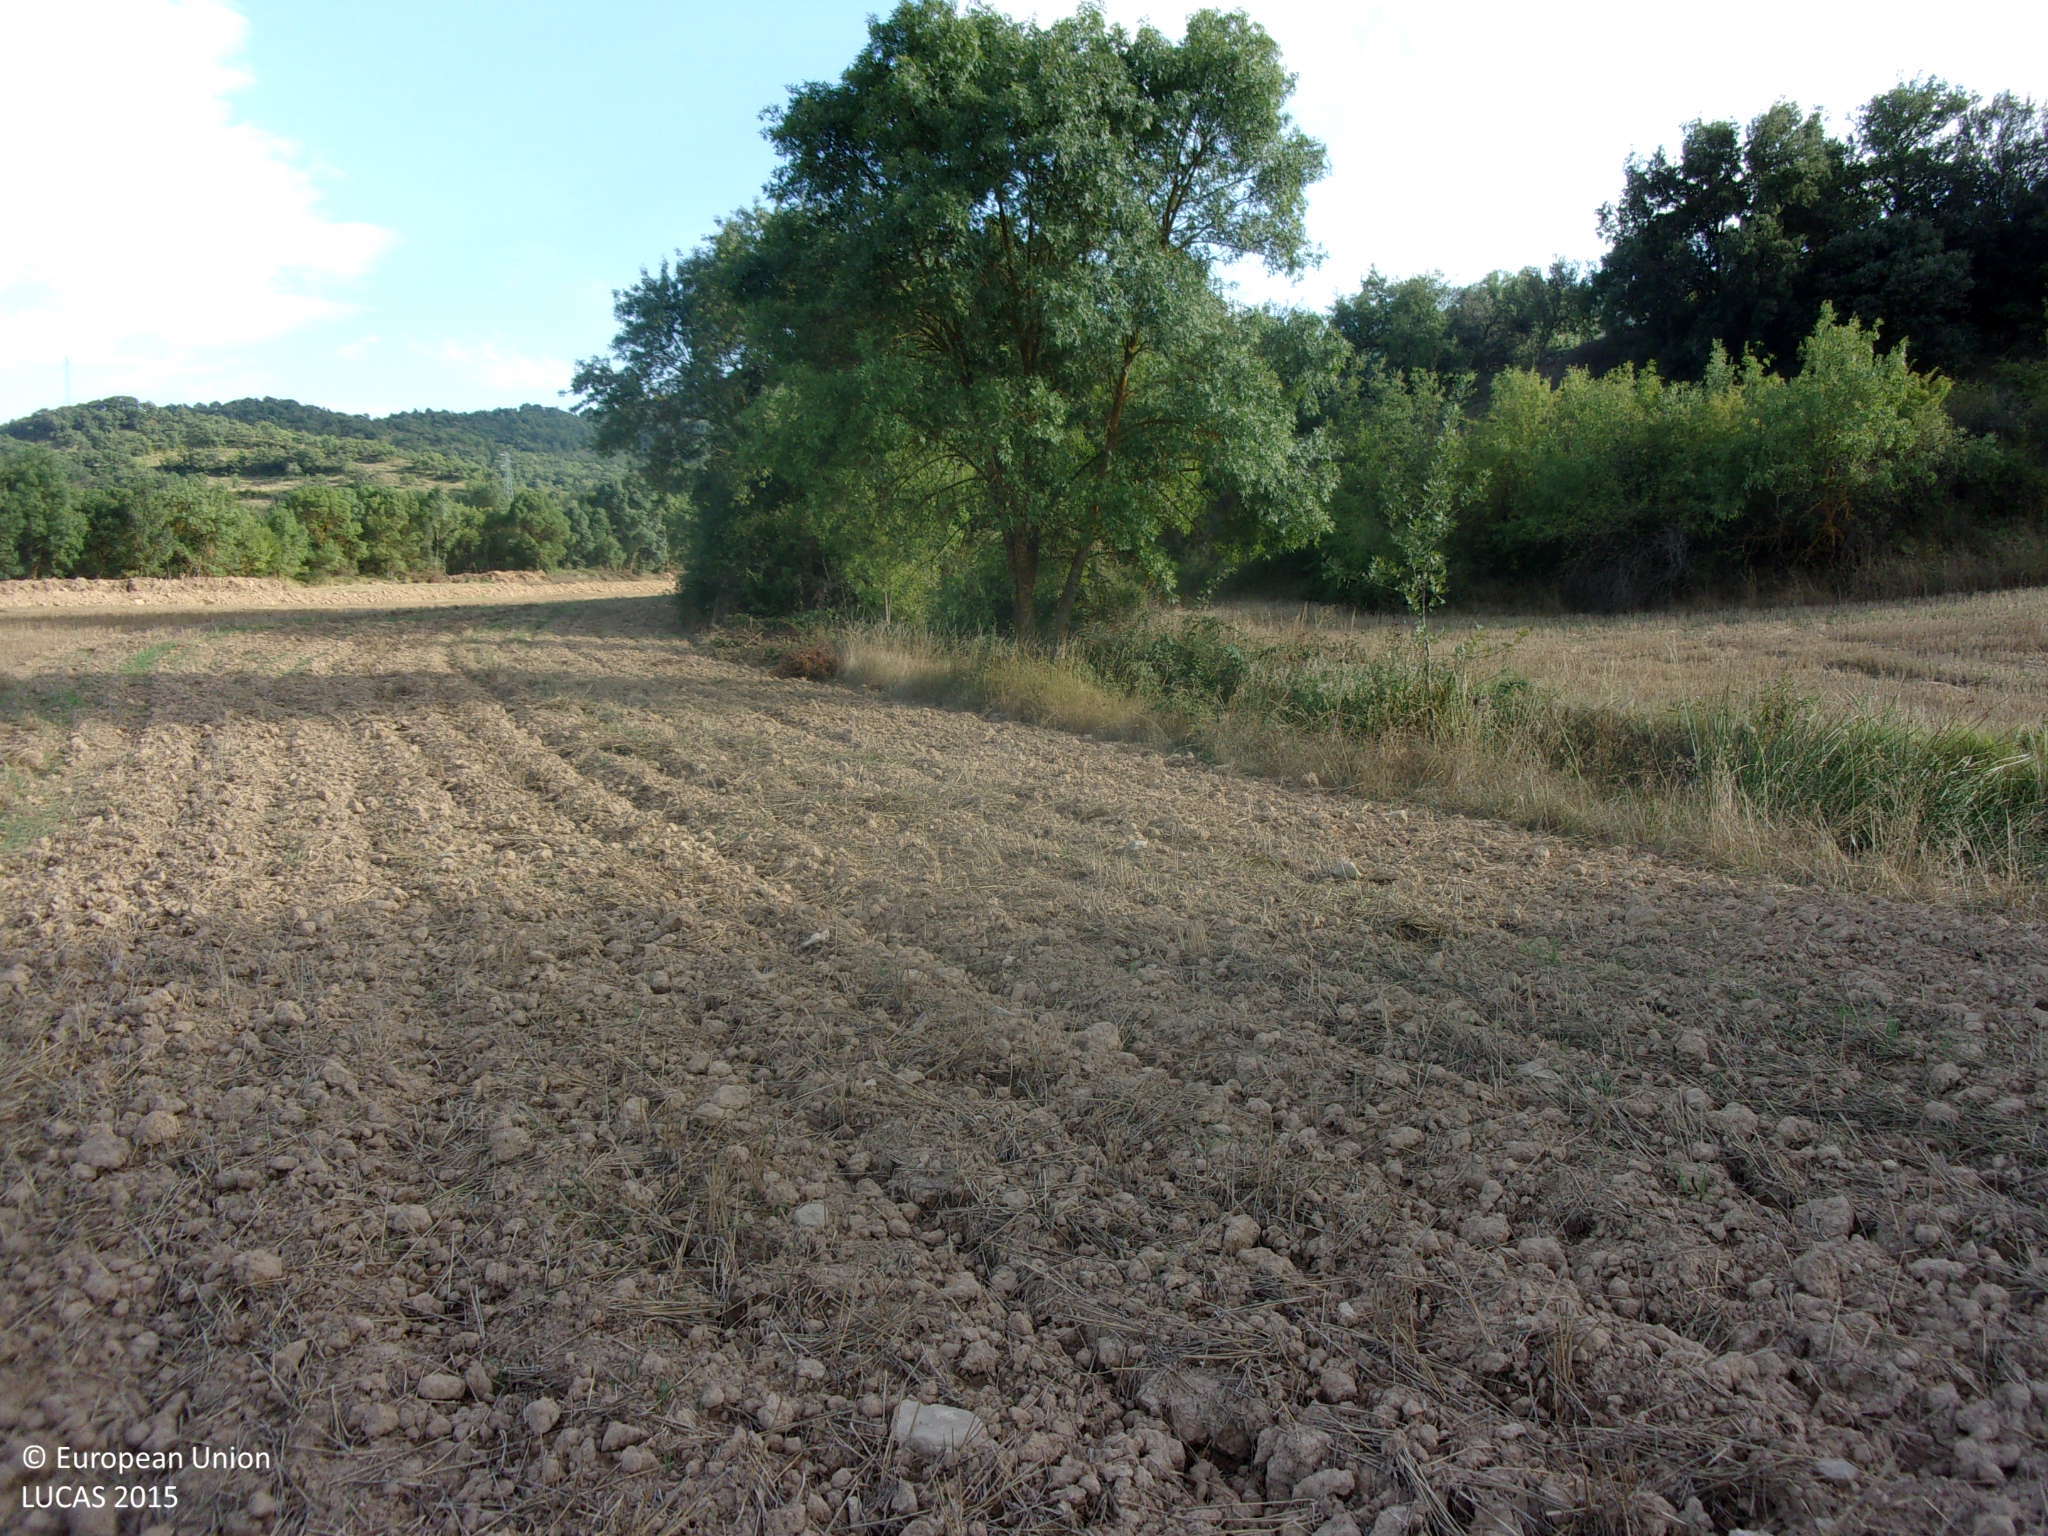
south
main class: Cropland
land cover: Common wheat
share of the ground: < 10 %
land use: Agriculture (excluding fallow land and kitchen gardens)
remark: Harvested field
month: August
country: ES
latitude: 42.4955
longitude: -1.1160
